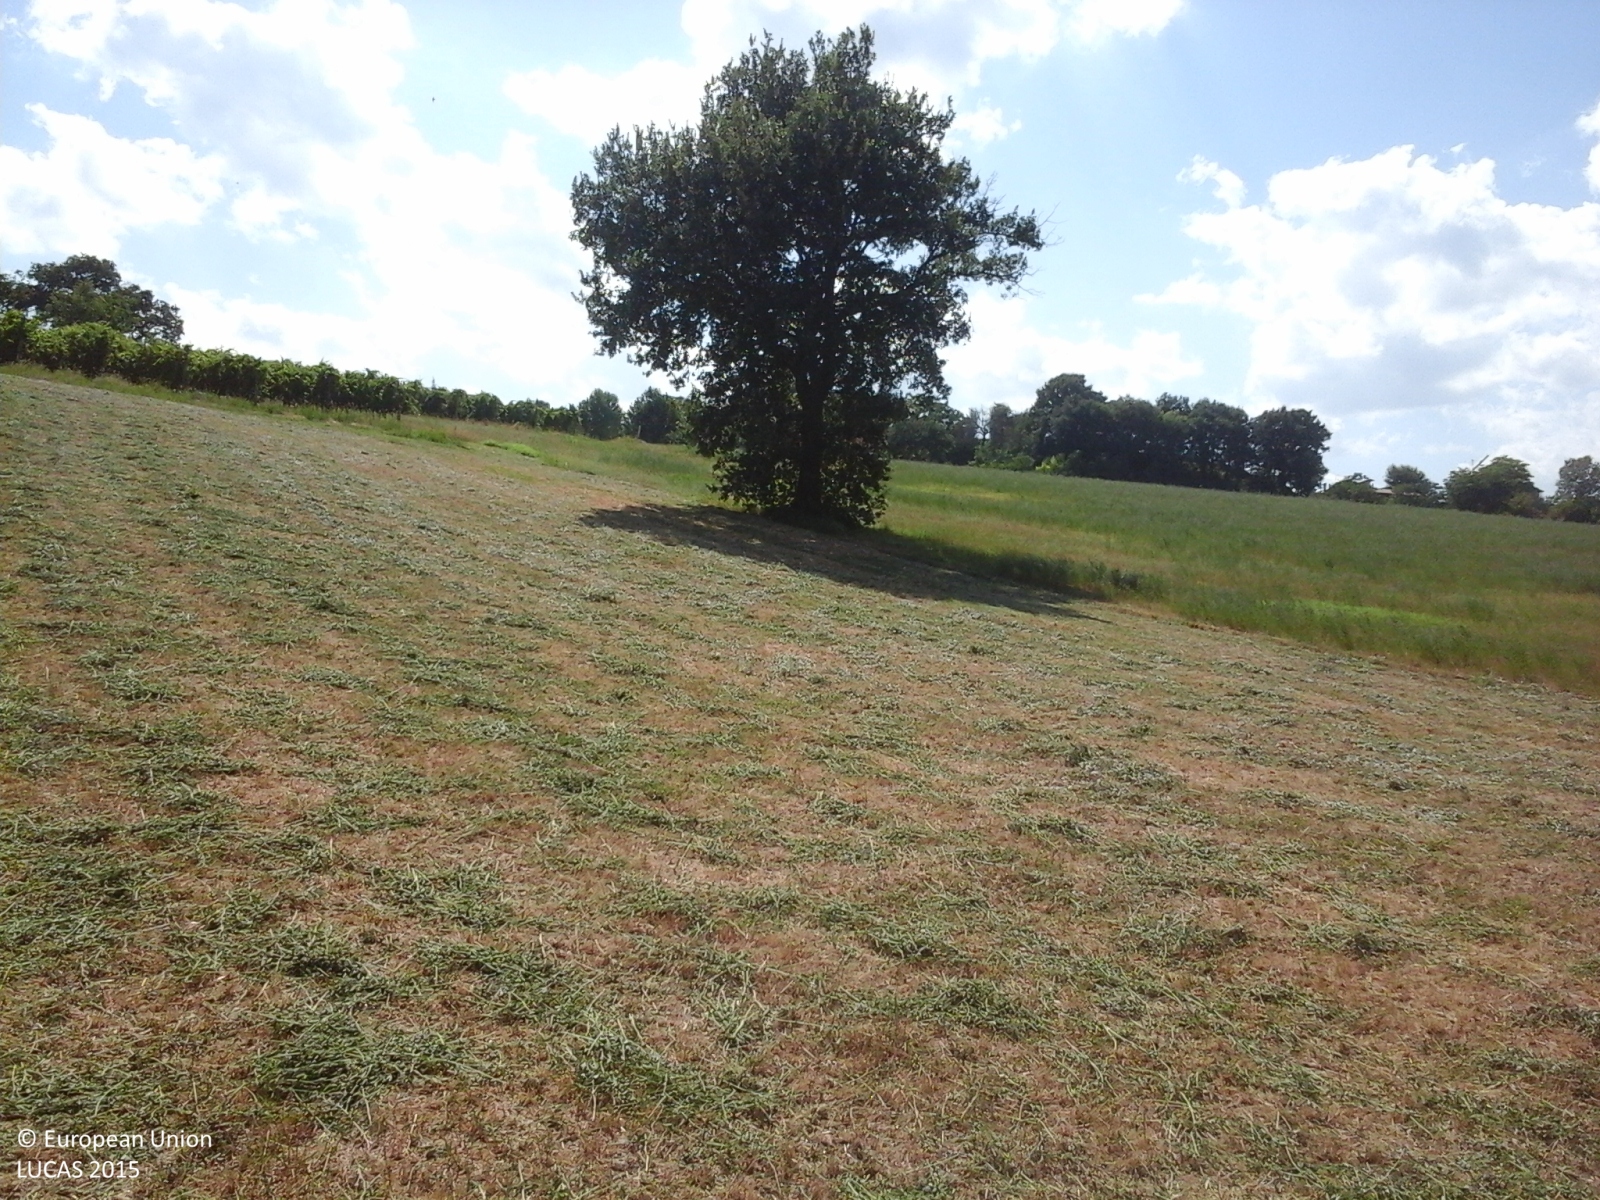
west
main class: Cropland
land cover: Lucerne
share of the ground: > 75 %
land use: Agriculture (excluding fallow land and kitchen gardens)
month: July
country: IT
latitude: 43.2350
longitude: 13.2299
